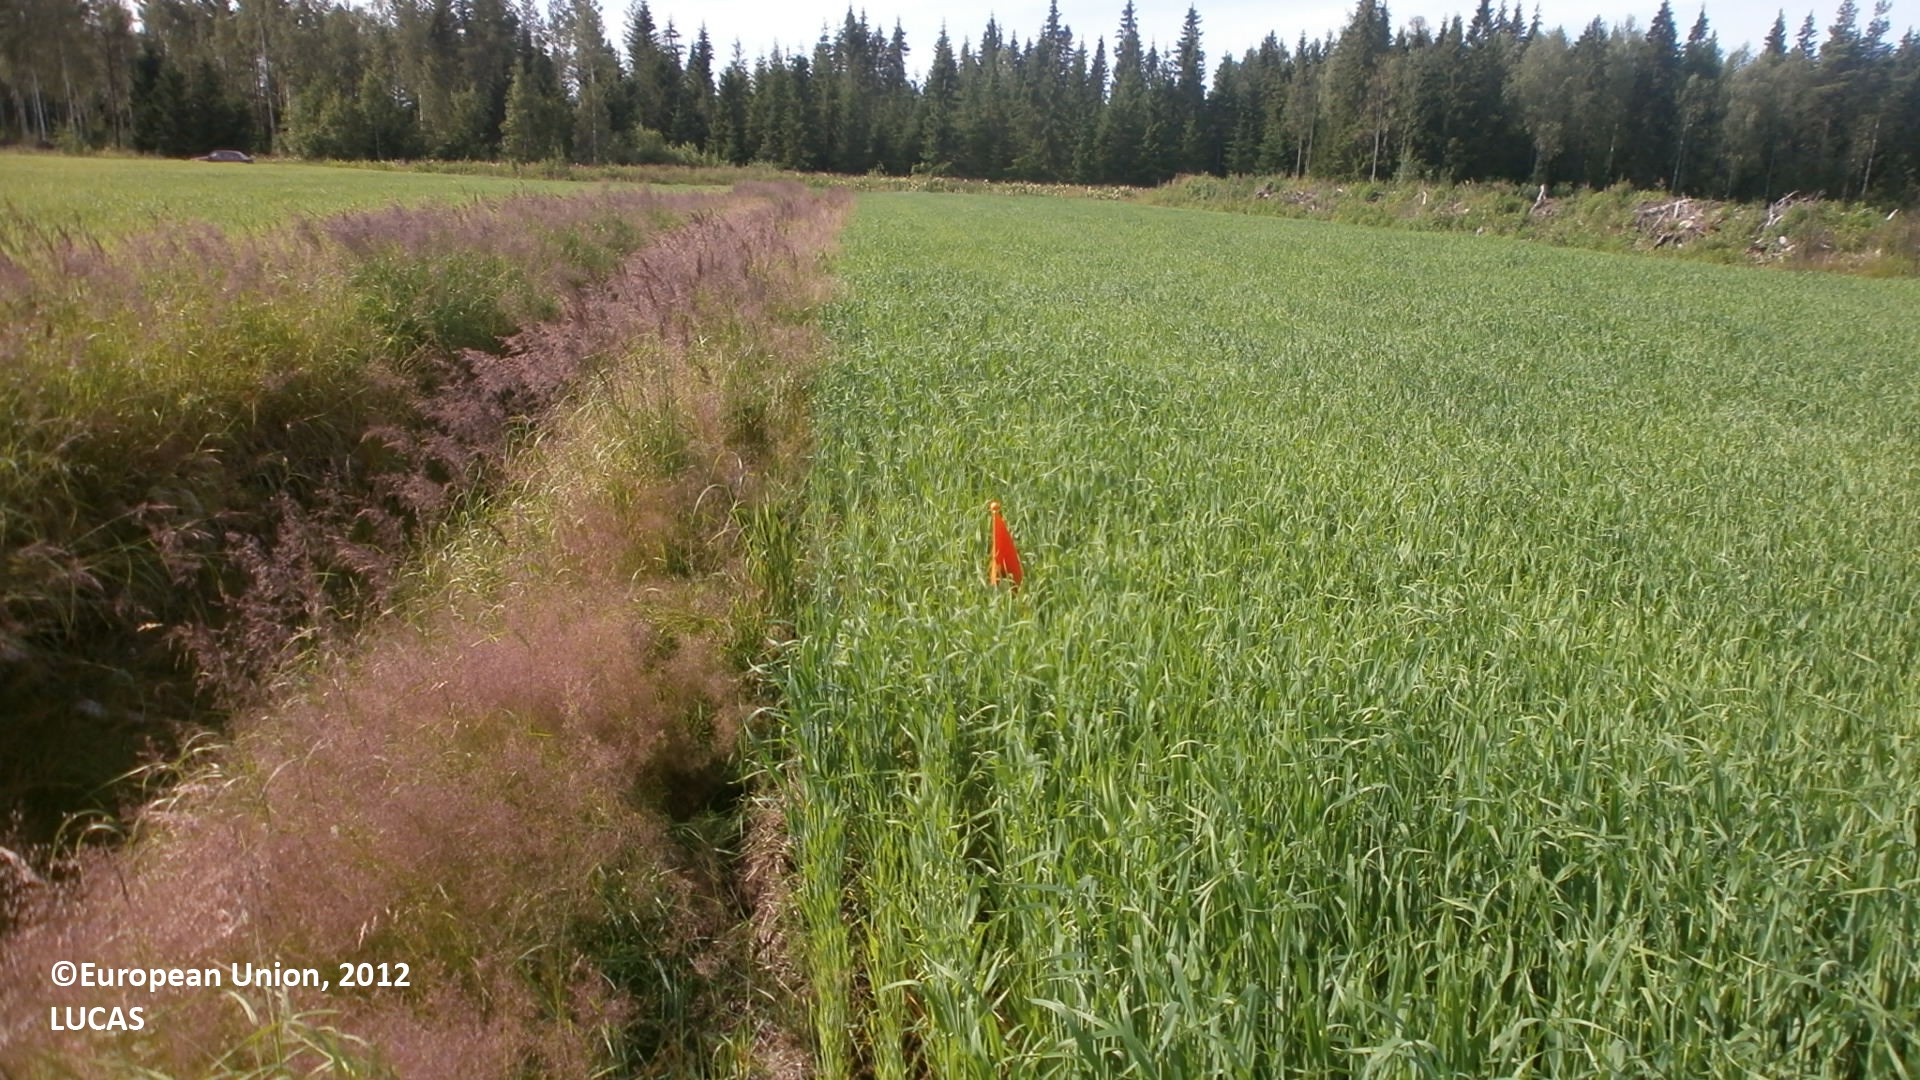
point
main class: Cropland
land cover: Oats
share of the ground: > 75 %
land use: Agriculture (excluding fallow land and kitchen gardens)
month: July
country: FI
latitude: 64.4007
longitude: 24.1907
